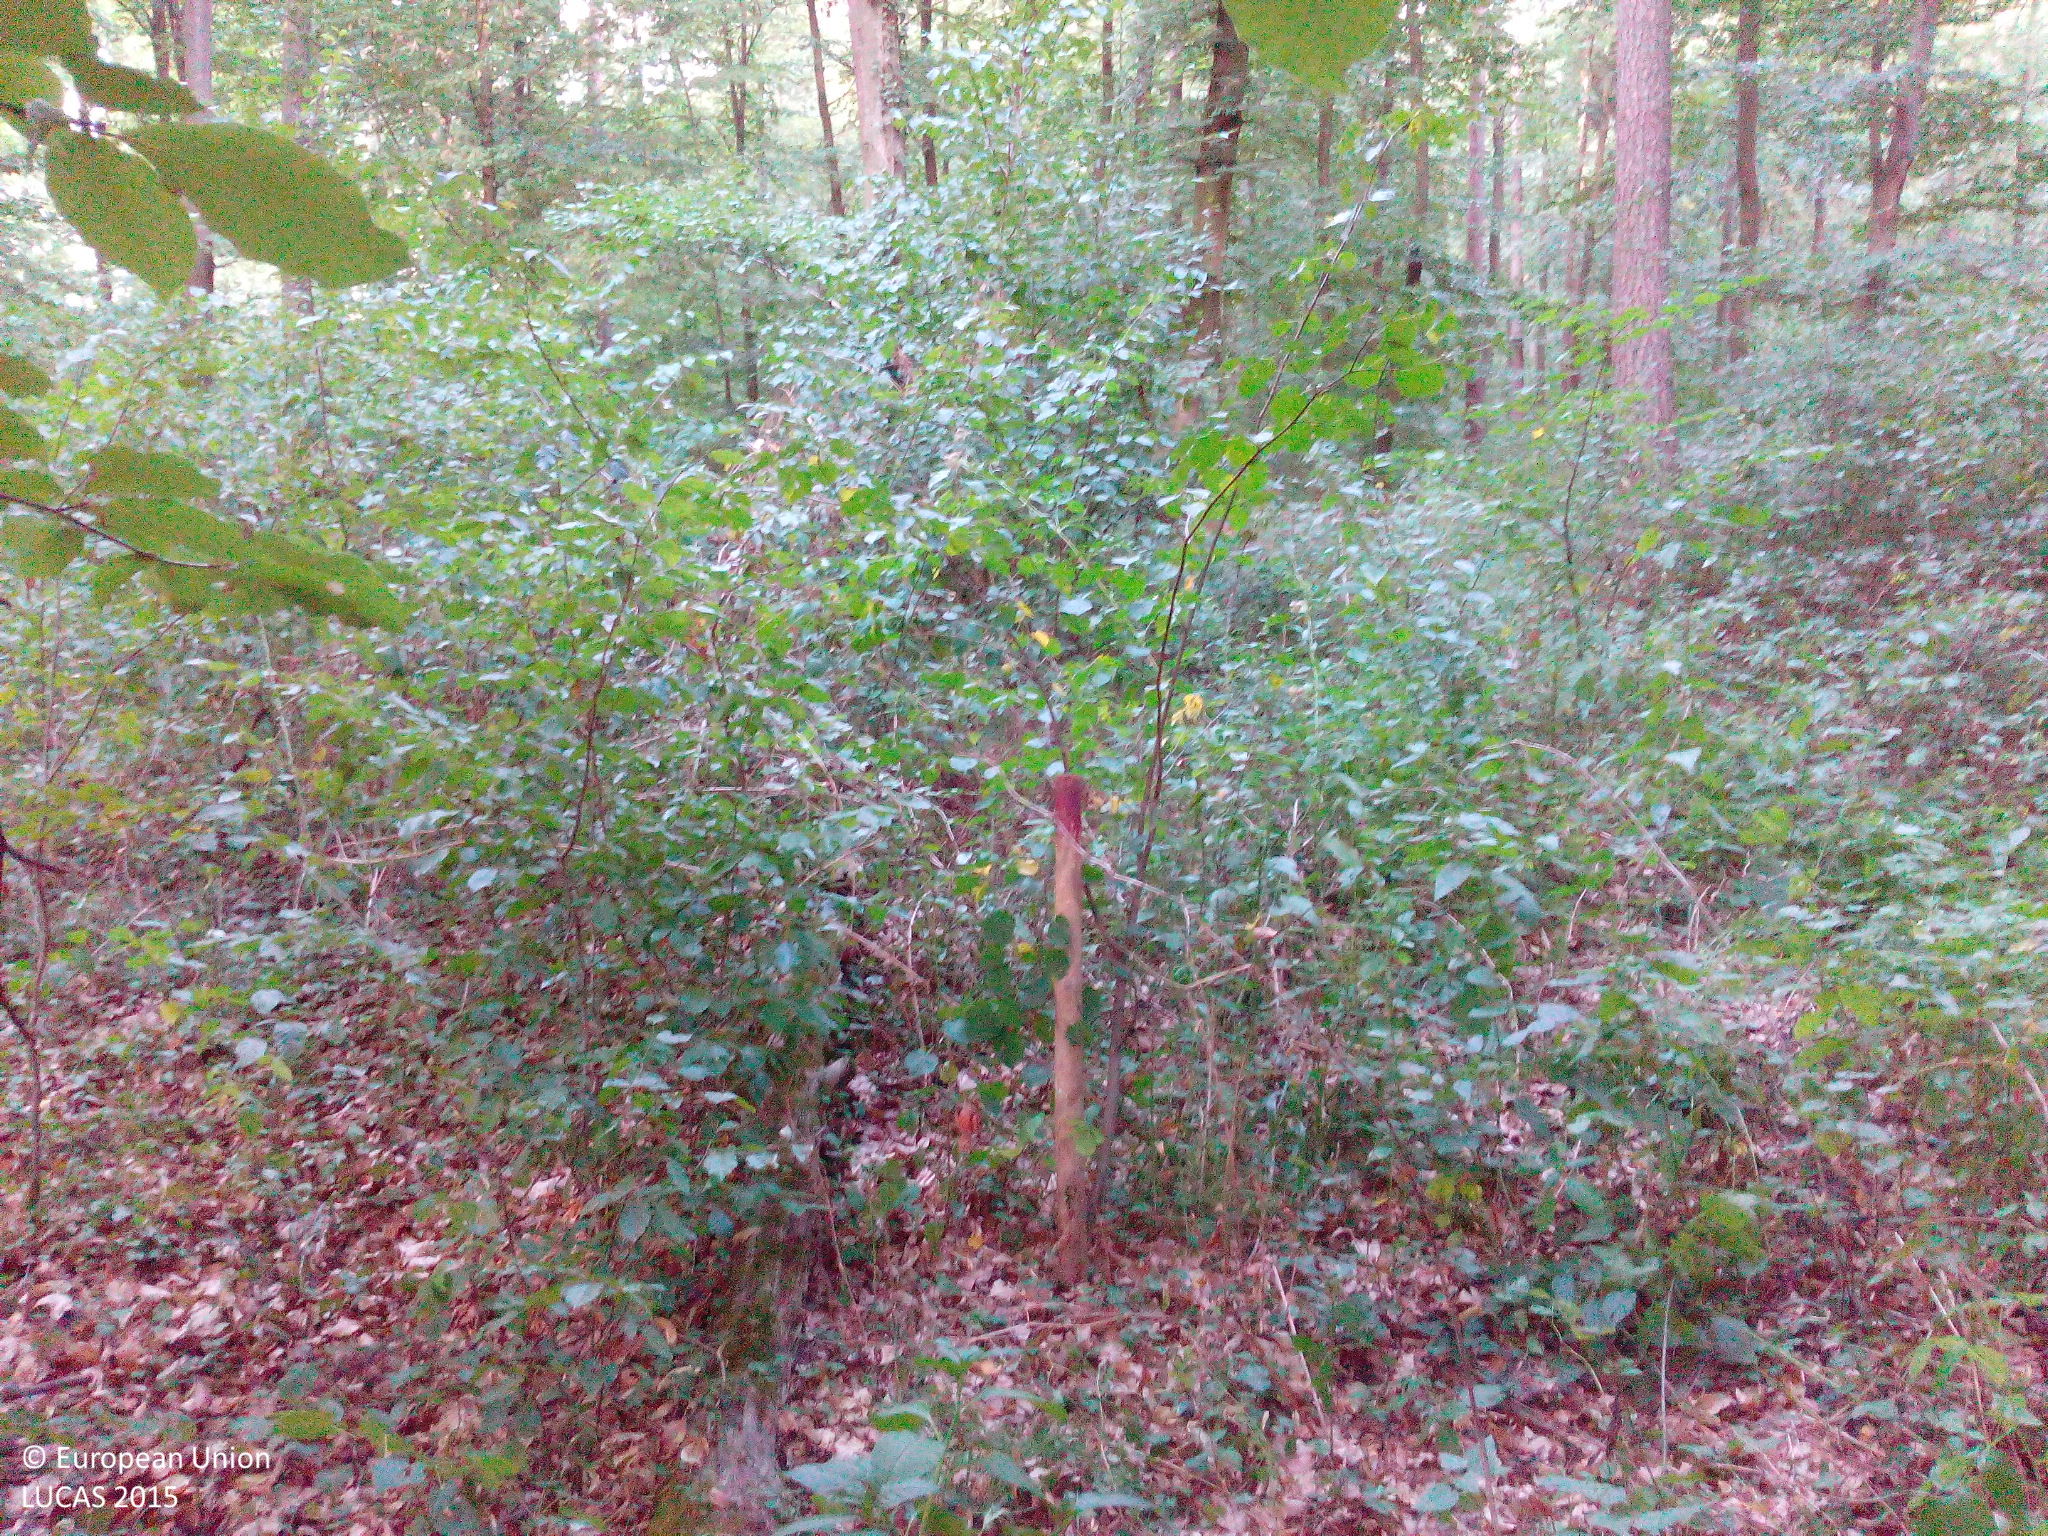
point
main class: Woodland
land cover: Pine dominated mixed woodland
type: hemiboreal forest and nemoral coniferous forest and mixed broadleaved-coniferous forest
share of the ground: > 75 %
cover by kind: broadleaved forest trees 60 %, coniferous forest trees 20 %, herbaceous plants 10 %, shrubs 5 %, unconsolidated bare surface 5 %
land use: Forestry
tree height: > 5 m
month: August
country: DE
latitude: 49.2757
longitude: 8.5573
